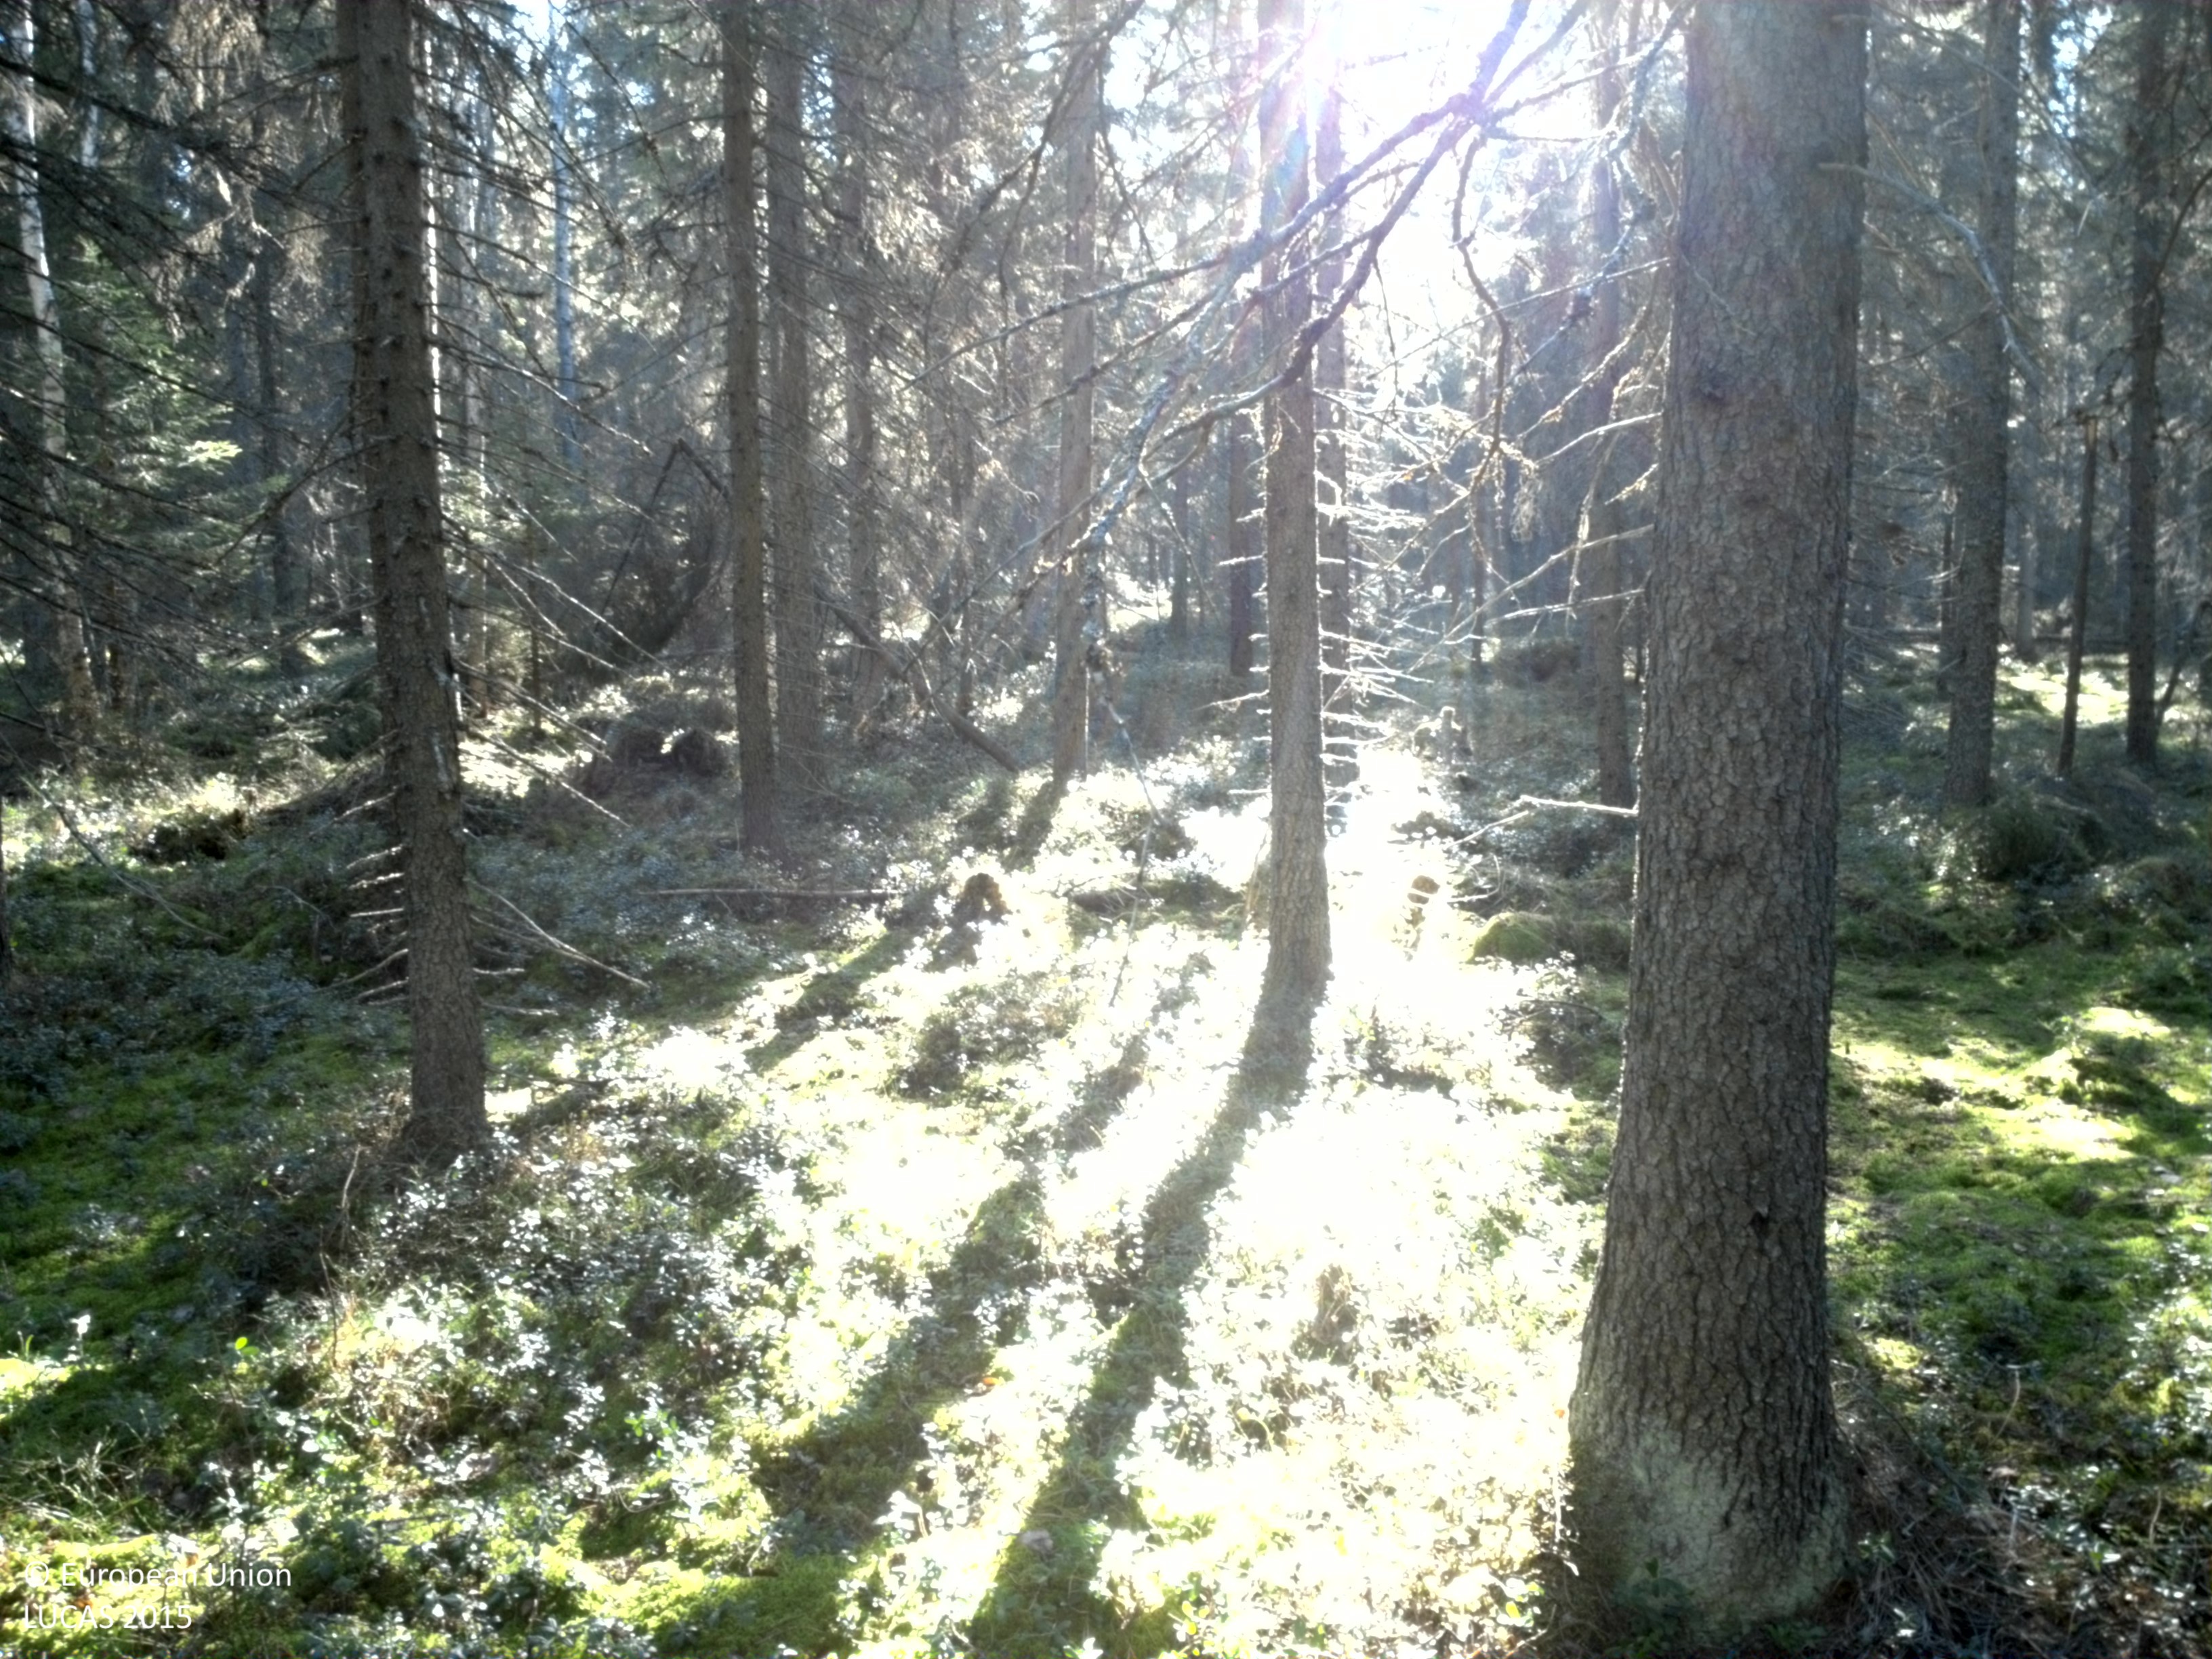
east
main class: Woodland
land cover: Spruce dominated coniferous woodland
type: boreal forest
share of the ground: > 75 %
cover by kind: coniferous forest trees 75 %, lichens and mosses 15 %, shrubs 10 %
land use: Forestry
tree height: > 5 m
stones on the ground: < 10 %
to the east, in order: Spruce dominated coniferous woodland; Pine dominated coniferous woodland
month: May
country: SE
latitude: 65.8797
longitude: 23.2569
